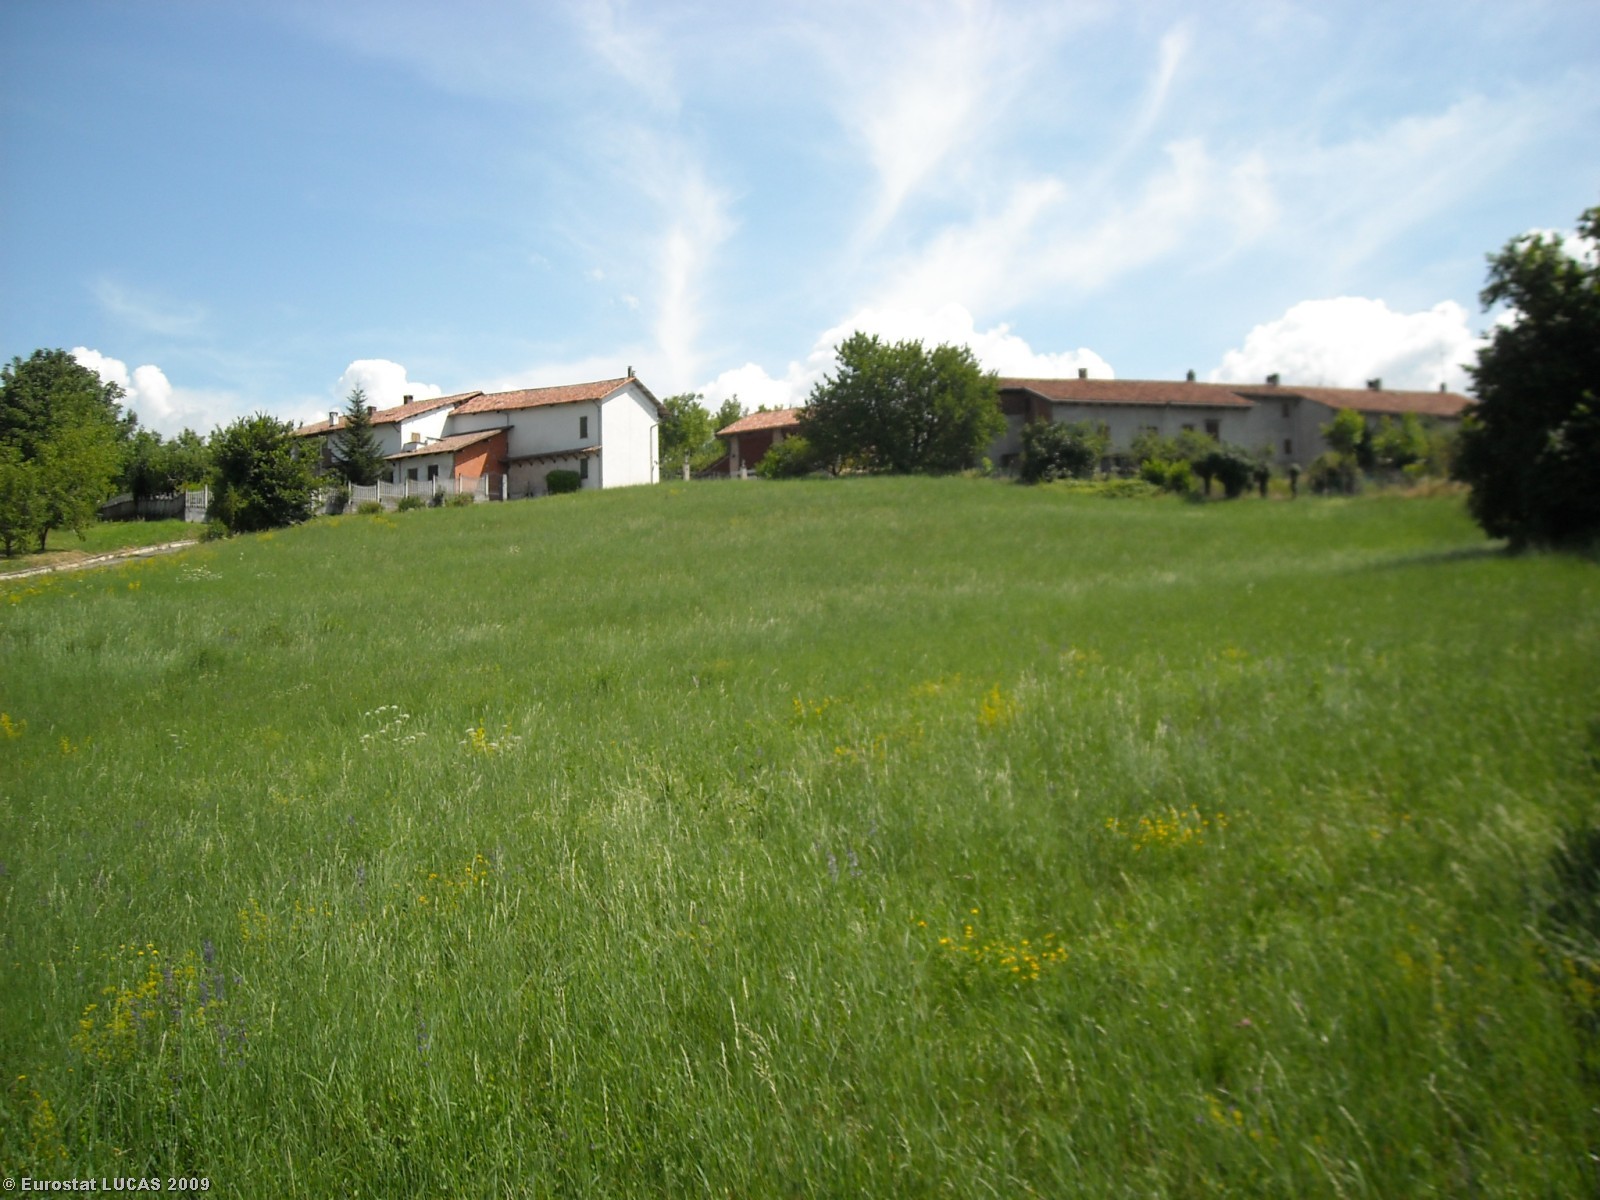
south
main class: Grassland
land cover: Grassland without tree/shrub cover
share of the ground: > 75 %
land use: Agriculture (excluding fallow land and kitchen gardens)
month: June
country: IT
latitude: 45.1625
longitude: 8.0824
